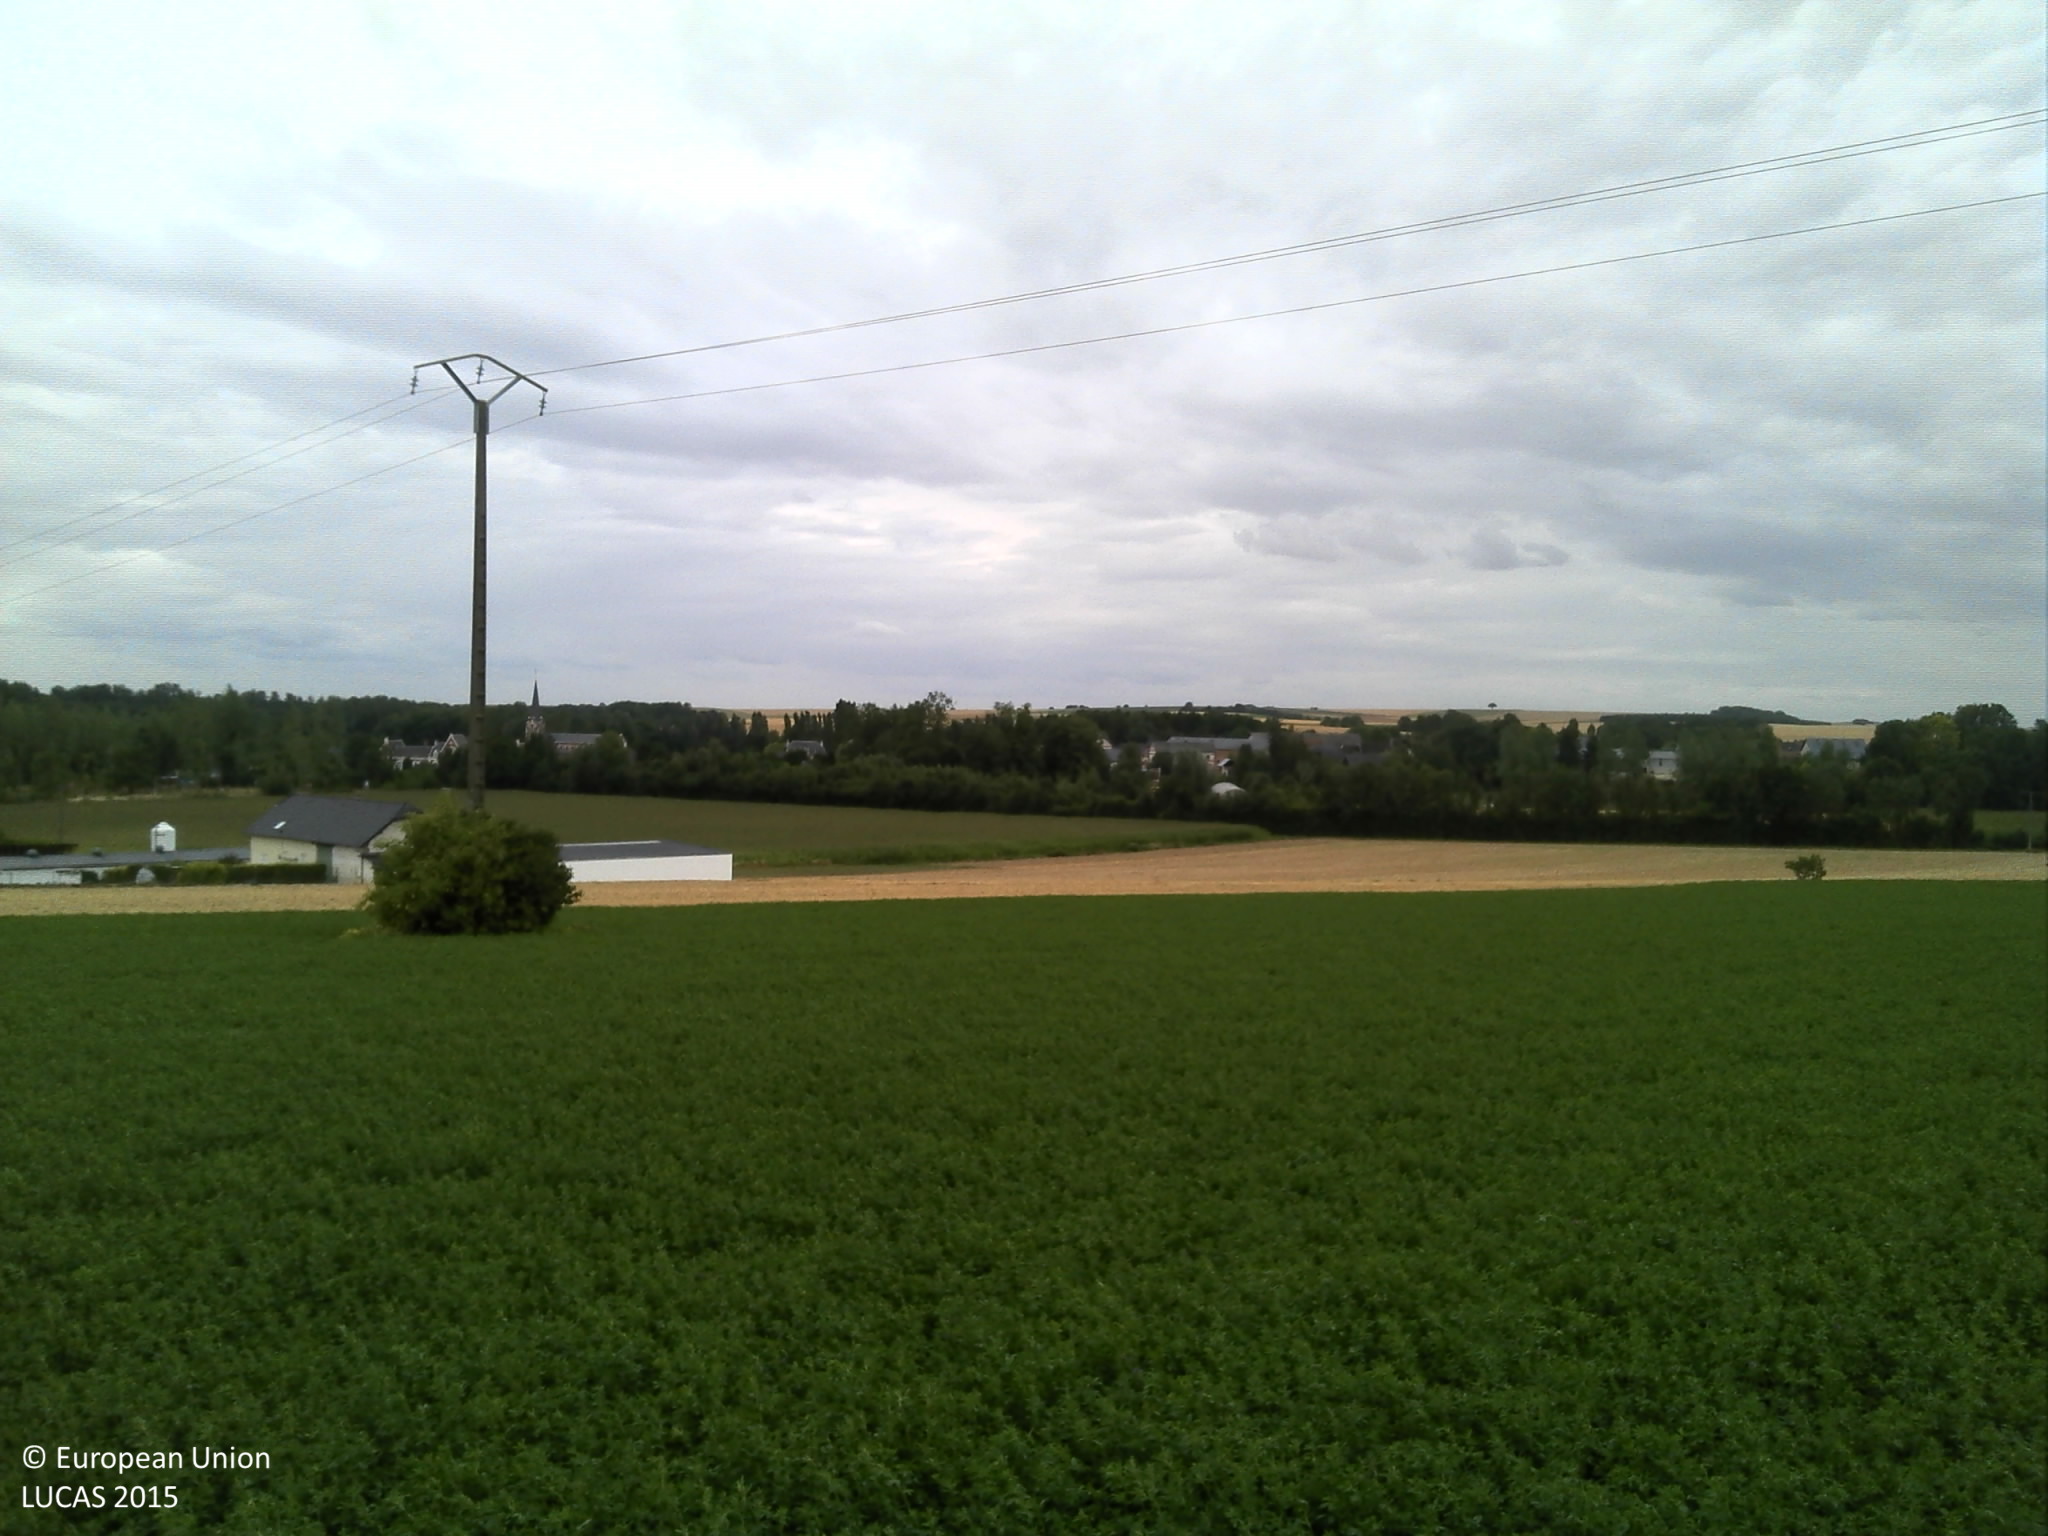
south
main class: Cropland
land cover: Lucerne
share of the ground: > 75 %
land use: Agriculture (excluding fallow land and kitchen gardens)
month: July
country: FR
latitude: 49.5443
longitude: 4.0936
